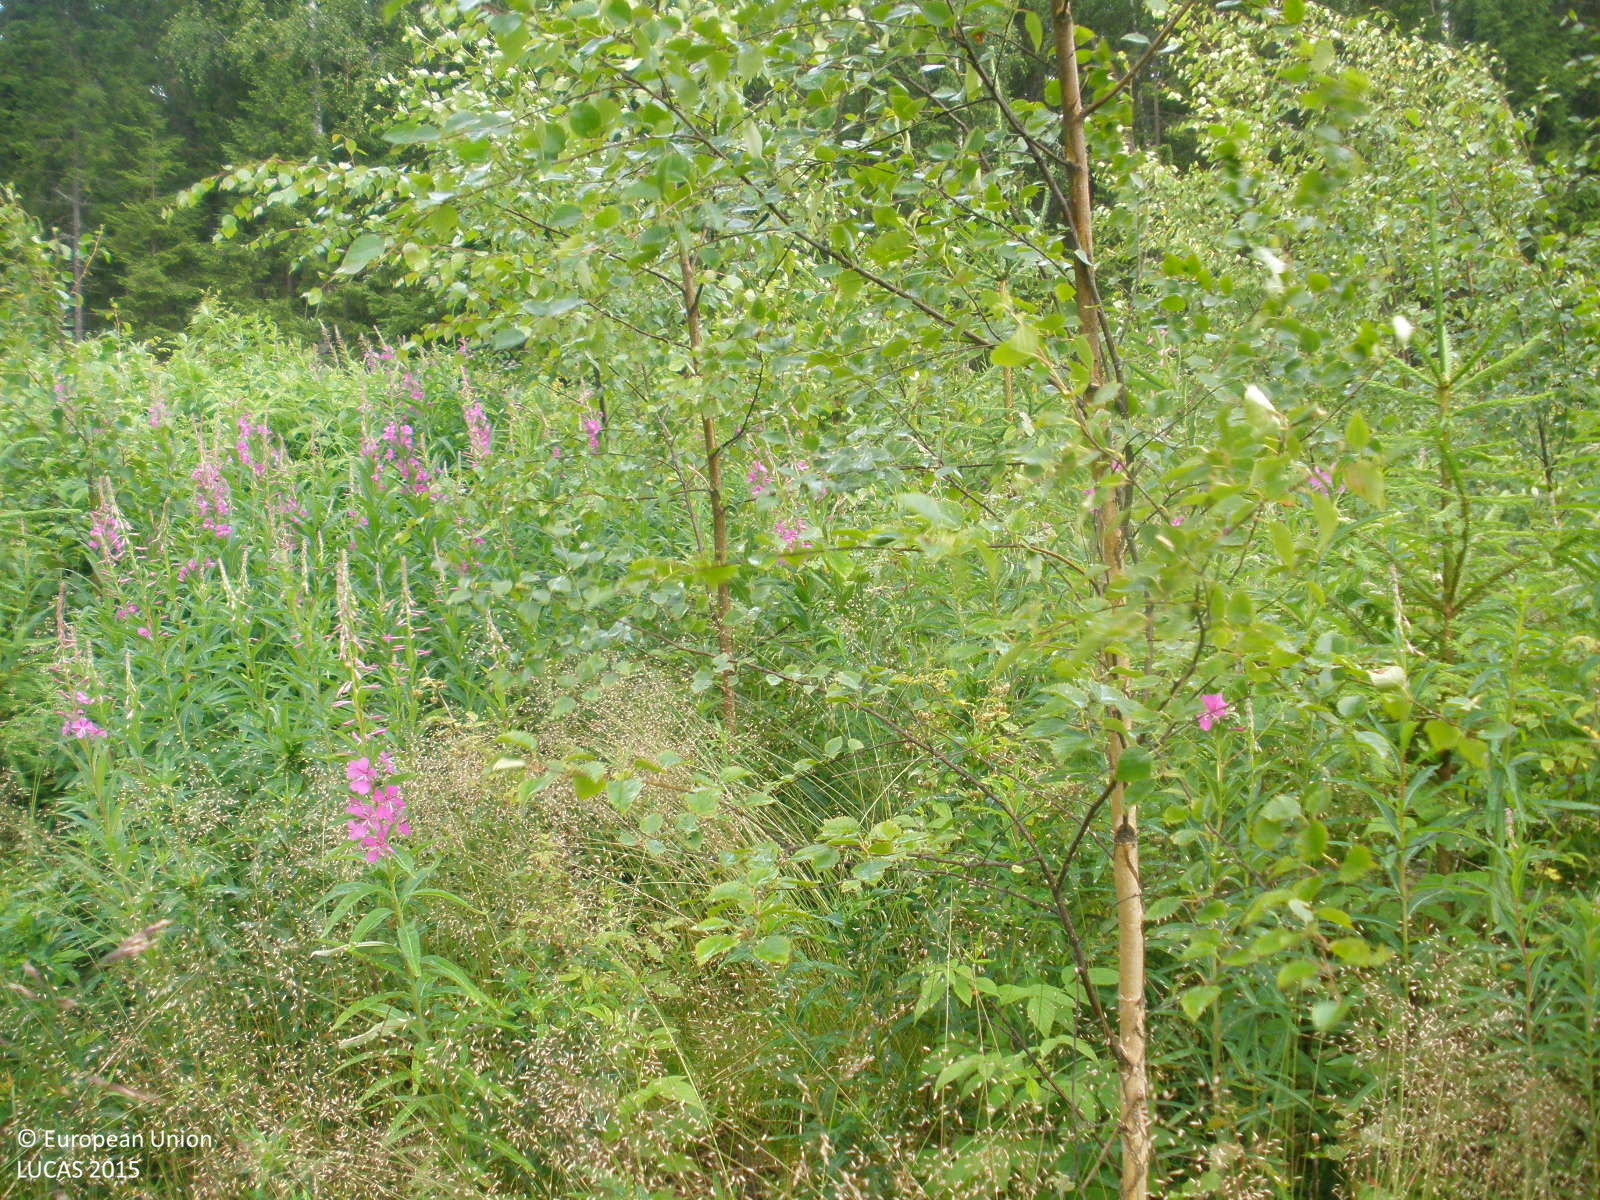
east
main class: Woodland
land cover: Other mixed woodland
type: boreal forest
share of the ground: 50 - 75 %
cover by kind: broadleaved forest trees 40 %, shrubs 35 %, coniferous forest trees 15 %, herbaceous plants 10 %
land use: Forestry
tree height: < 5 m
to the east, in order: Other mixed woodland; Grass margins; Paved roads, cycling and walking lanes; Grass margins; Spruce dominated coniferous woodland; Ditches and canals; Spruce dominated mixed woodland
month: July
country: FI
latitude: 61.4213
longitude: 24.7398
